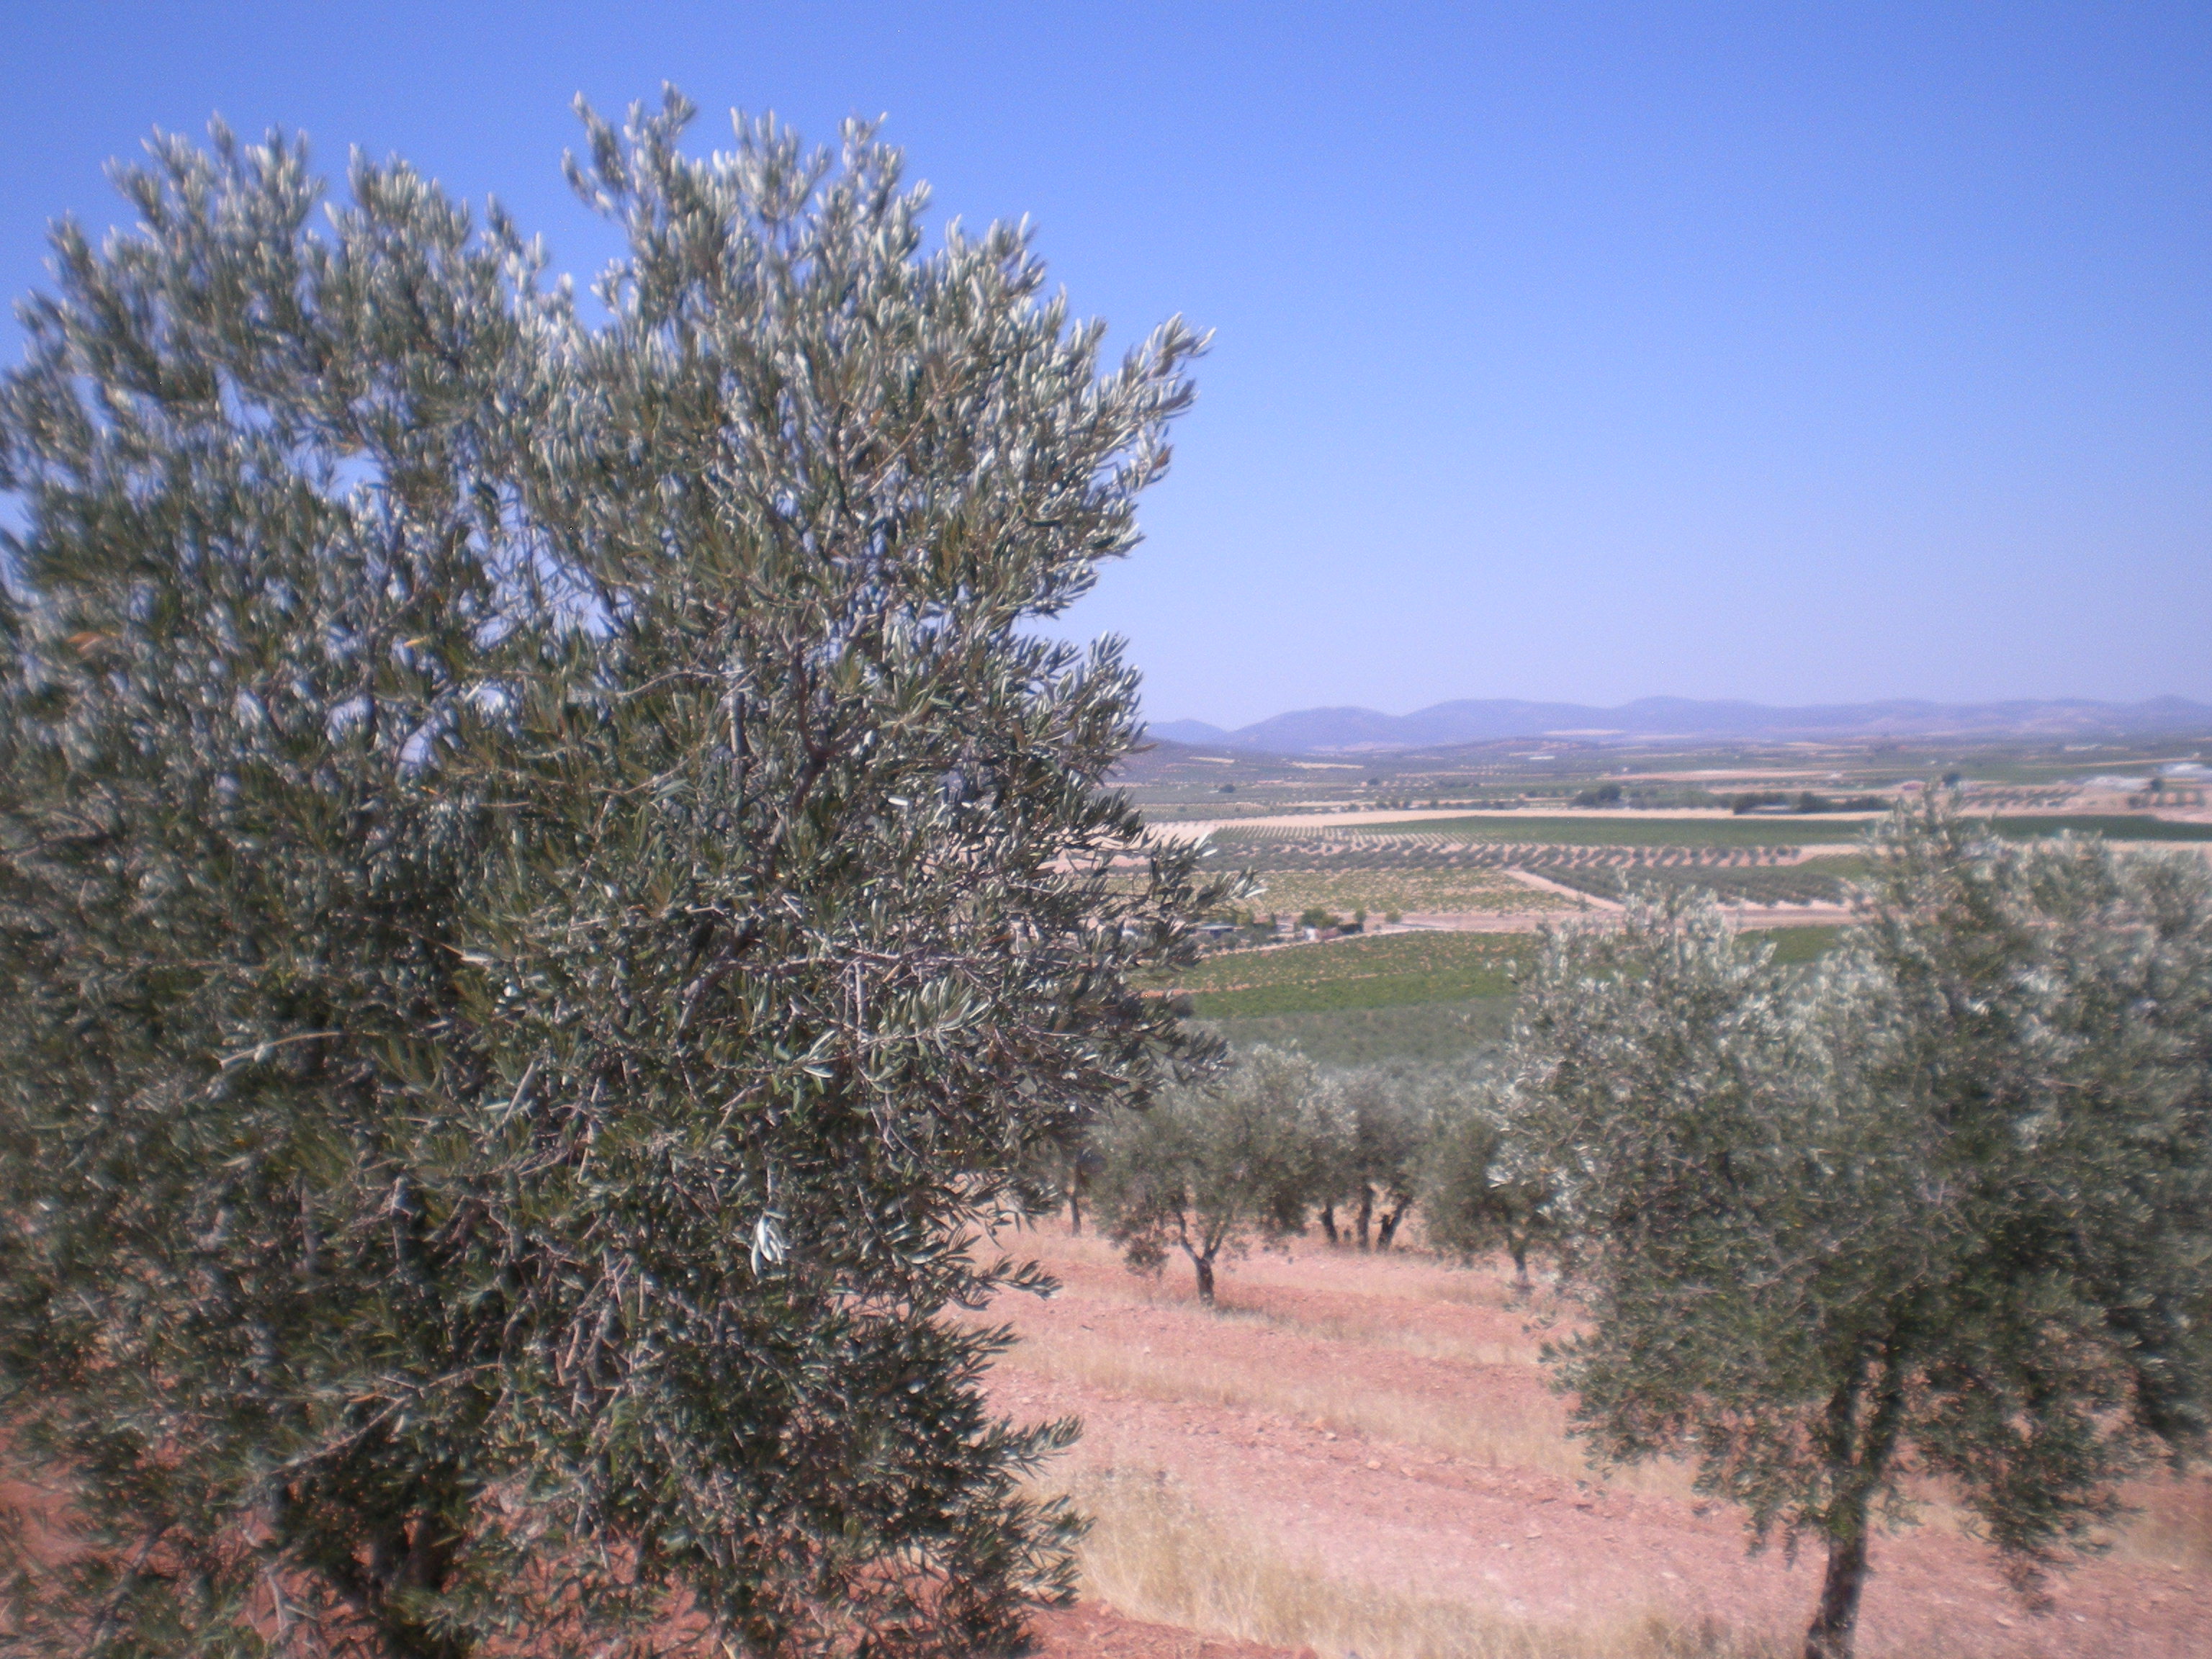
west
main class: Cropland
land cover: Olive groves
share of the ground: 25 - 50 %
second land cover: Spontaneously vegetated surfaces
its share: 10 - 25 %
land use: Agriculture (excluding fallow land and kitchen gardens)
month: July
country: ES
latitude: 39.3502
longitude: -3.3520
